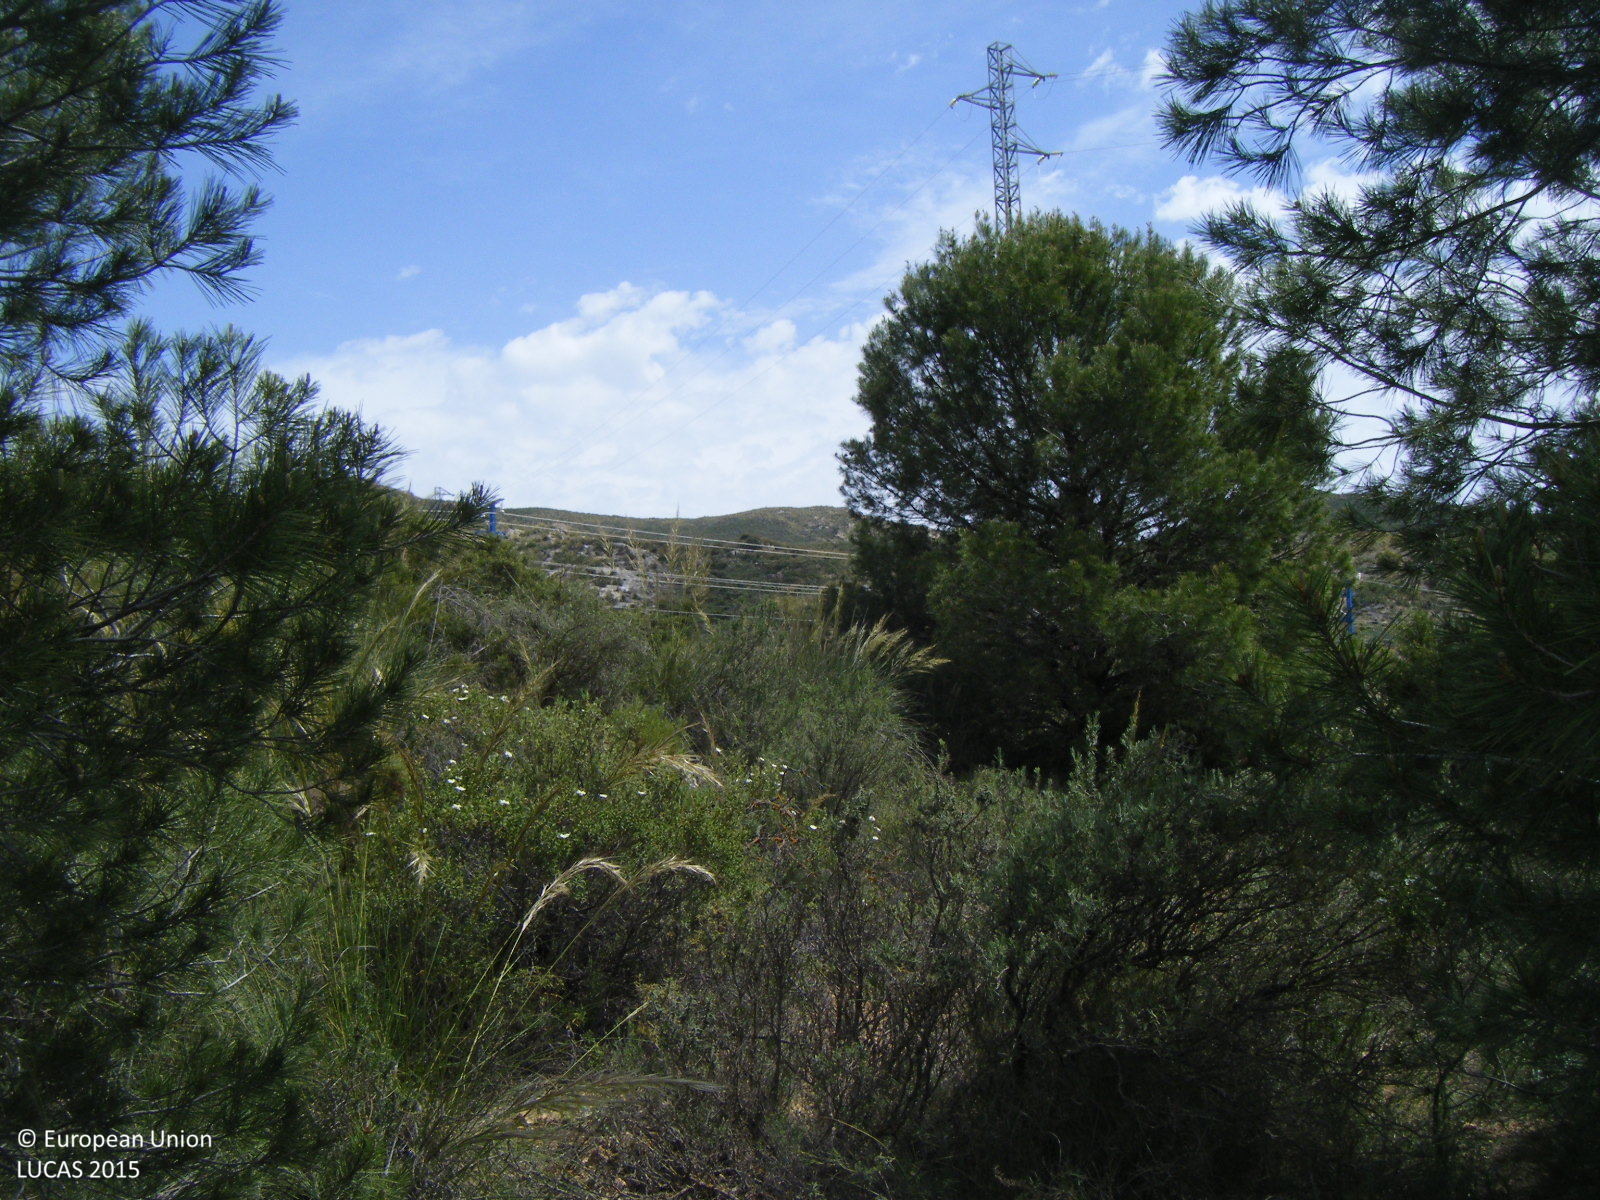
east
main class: Shrubland
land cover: Shrubland with sparse tree cover
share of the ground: > 75 %
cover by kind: shrubs 95 %, coniferous forest trees 5 %
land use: Semi-natural and natural areas not in use
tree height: > 5 m
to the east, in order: Shrubland with sparse tree cover; Shrubland without tree cover; Tracks; Fences; Other bare soil; Tracks; Electric lines; Railways; Electric lines; Shrubland without tree cover; Fences; Tracks; Shrubland without tree cover
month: April
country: ES
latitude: 36.9985
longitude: -4.7298
